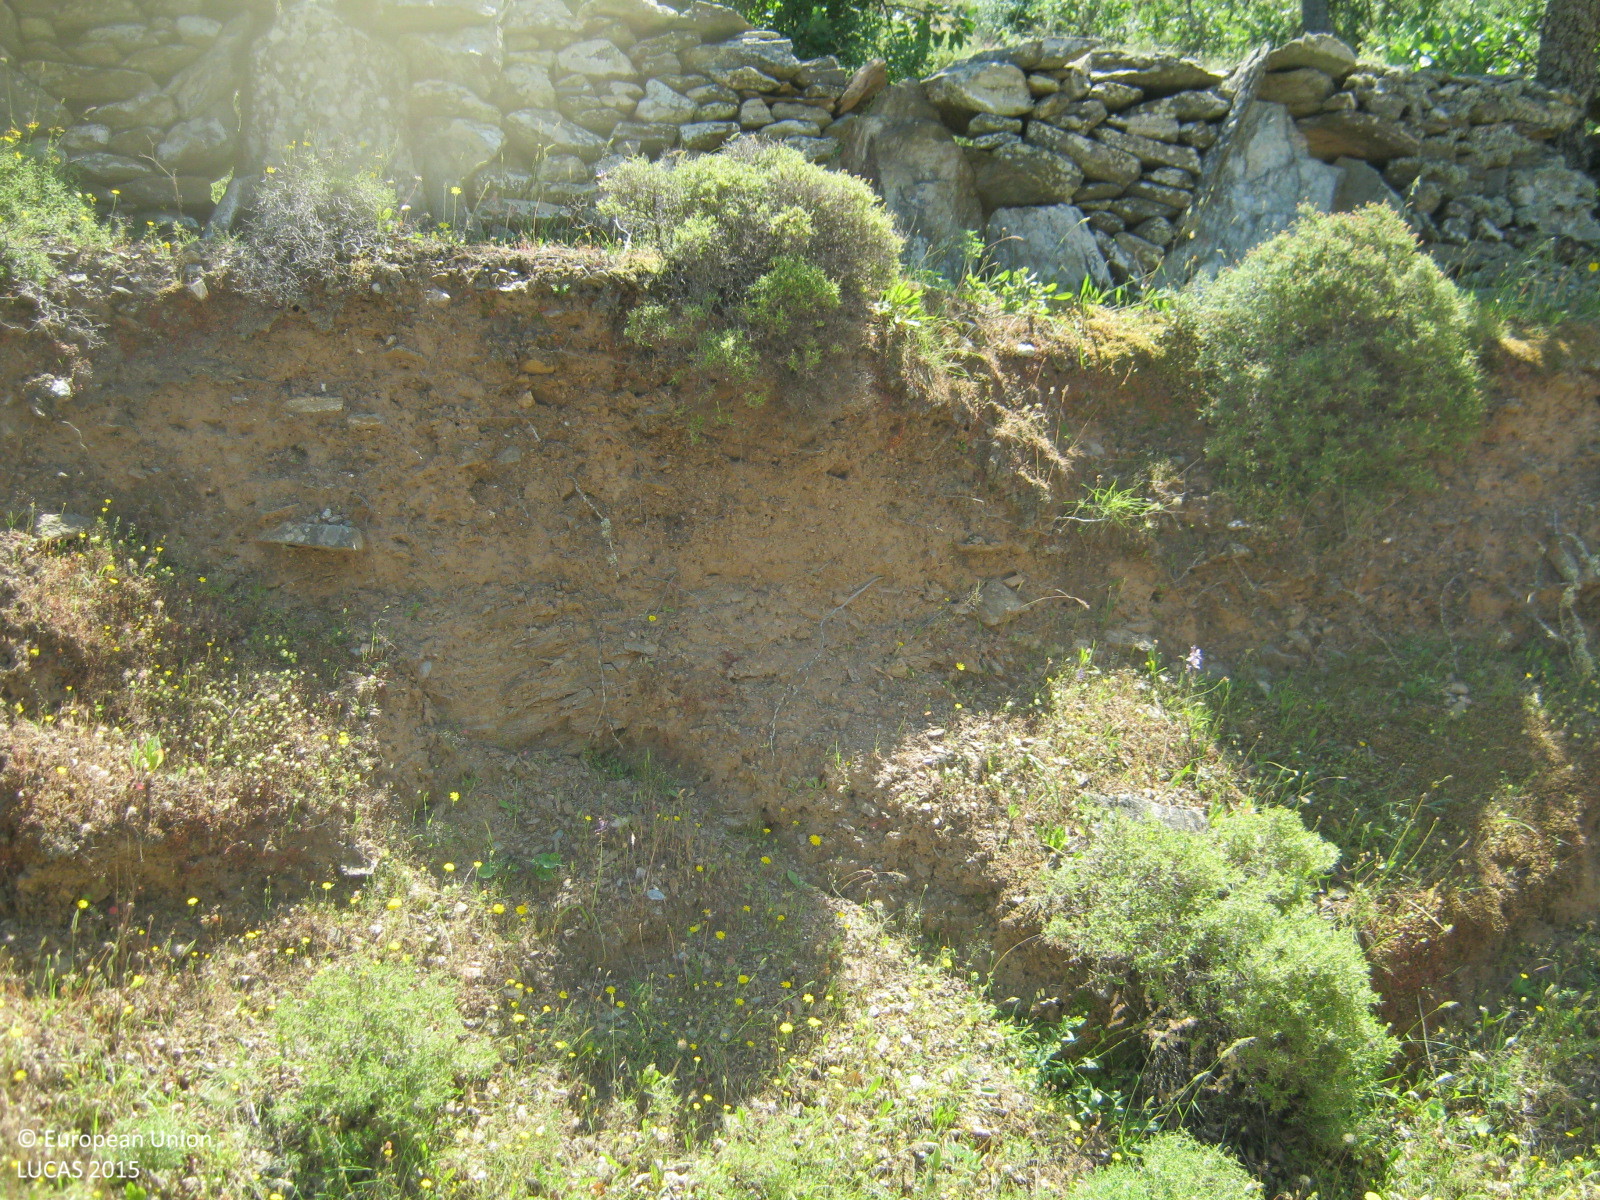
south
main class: Woodland
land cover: Broadleaved woodland
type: thermophilous deciduous forest
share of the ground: > 75 %
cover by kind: broadleaved forest trees 75 %, herbaceous plants 10 %, unconsolidated bare surface 10 %, shrubs 5 %
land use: Semi-natural and natural areas not in use
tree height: > 5 m
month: May
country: GR
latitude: 37.6079
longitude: 24.3568
